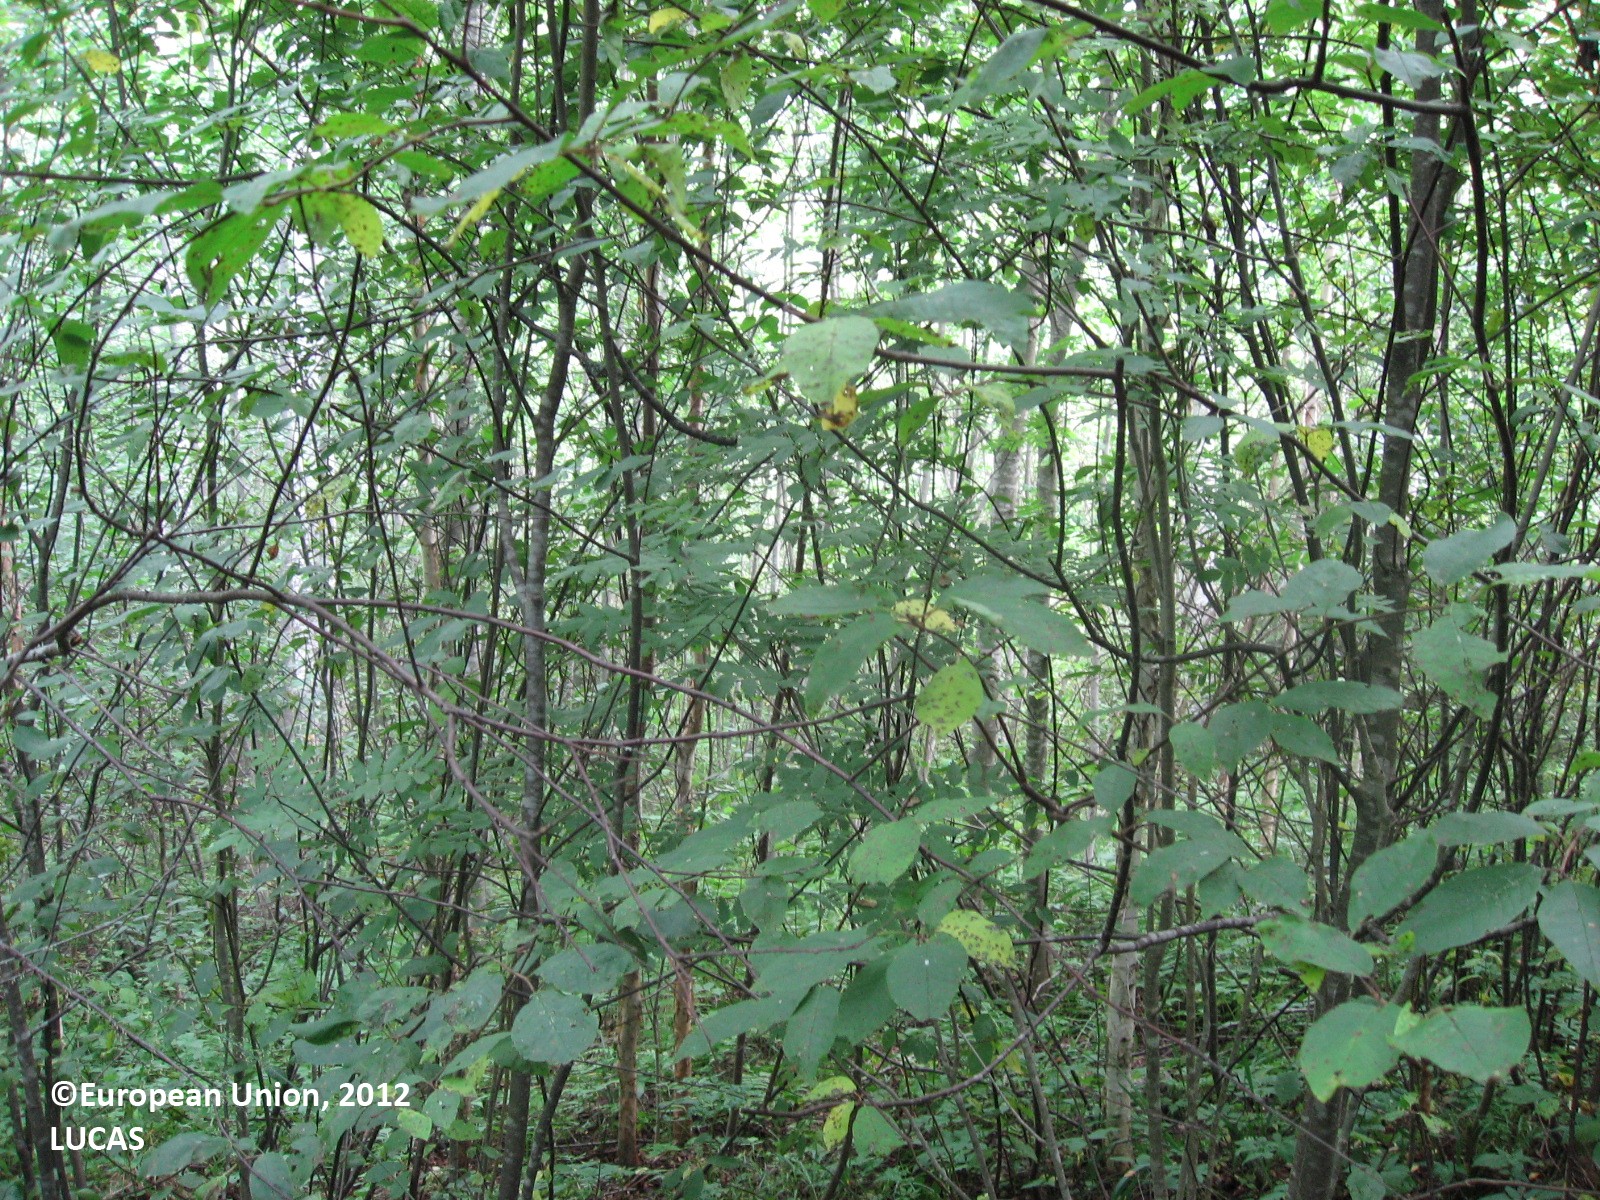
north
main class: Woodland
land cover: Broadleaved woodland
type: boreal forest
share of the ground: > 75 %
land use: Forestry
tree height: > 5 m
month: July
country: FI
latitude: 61.2256
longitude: 25.7164
